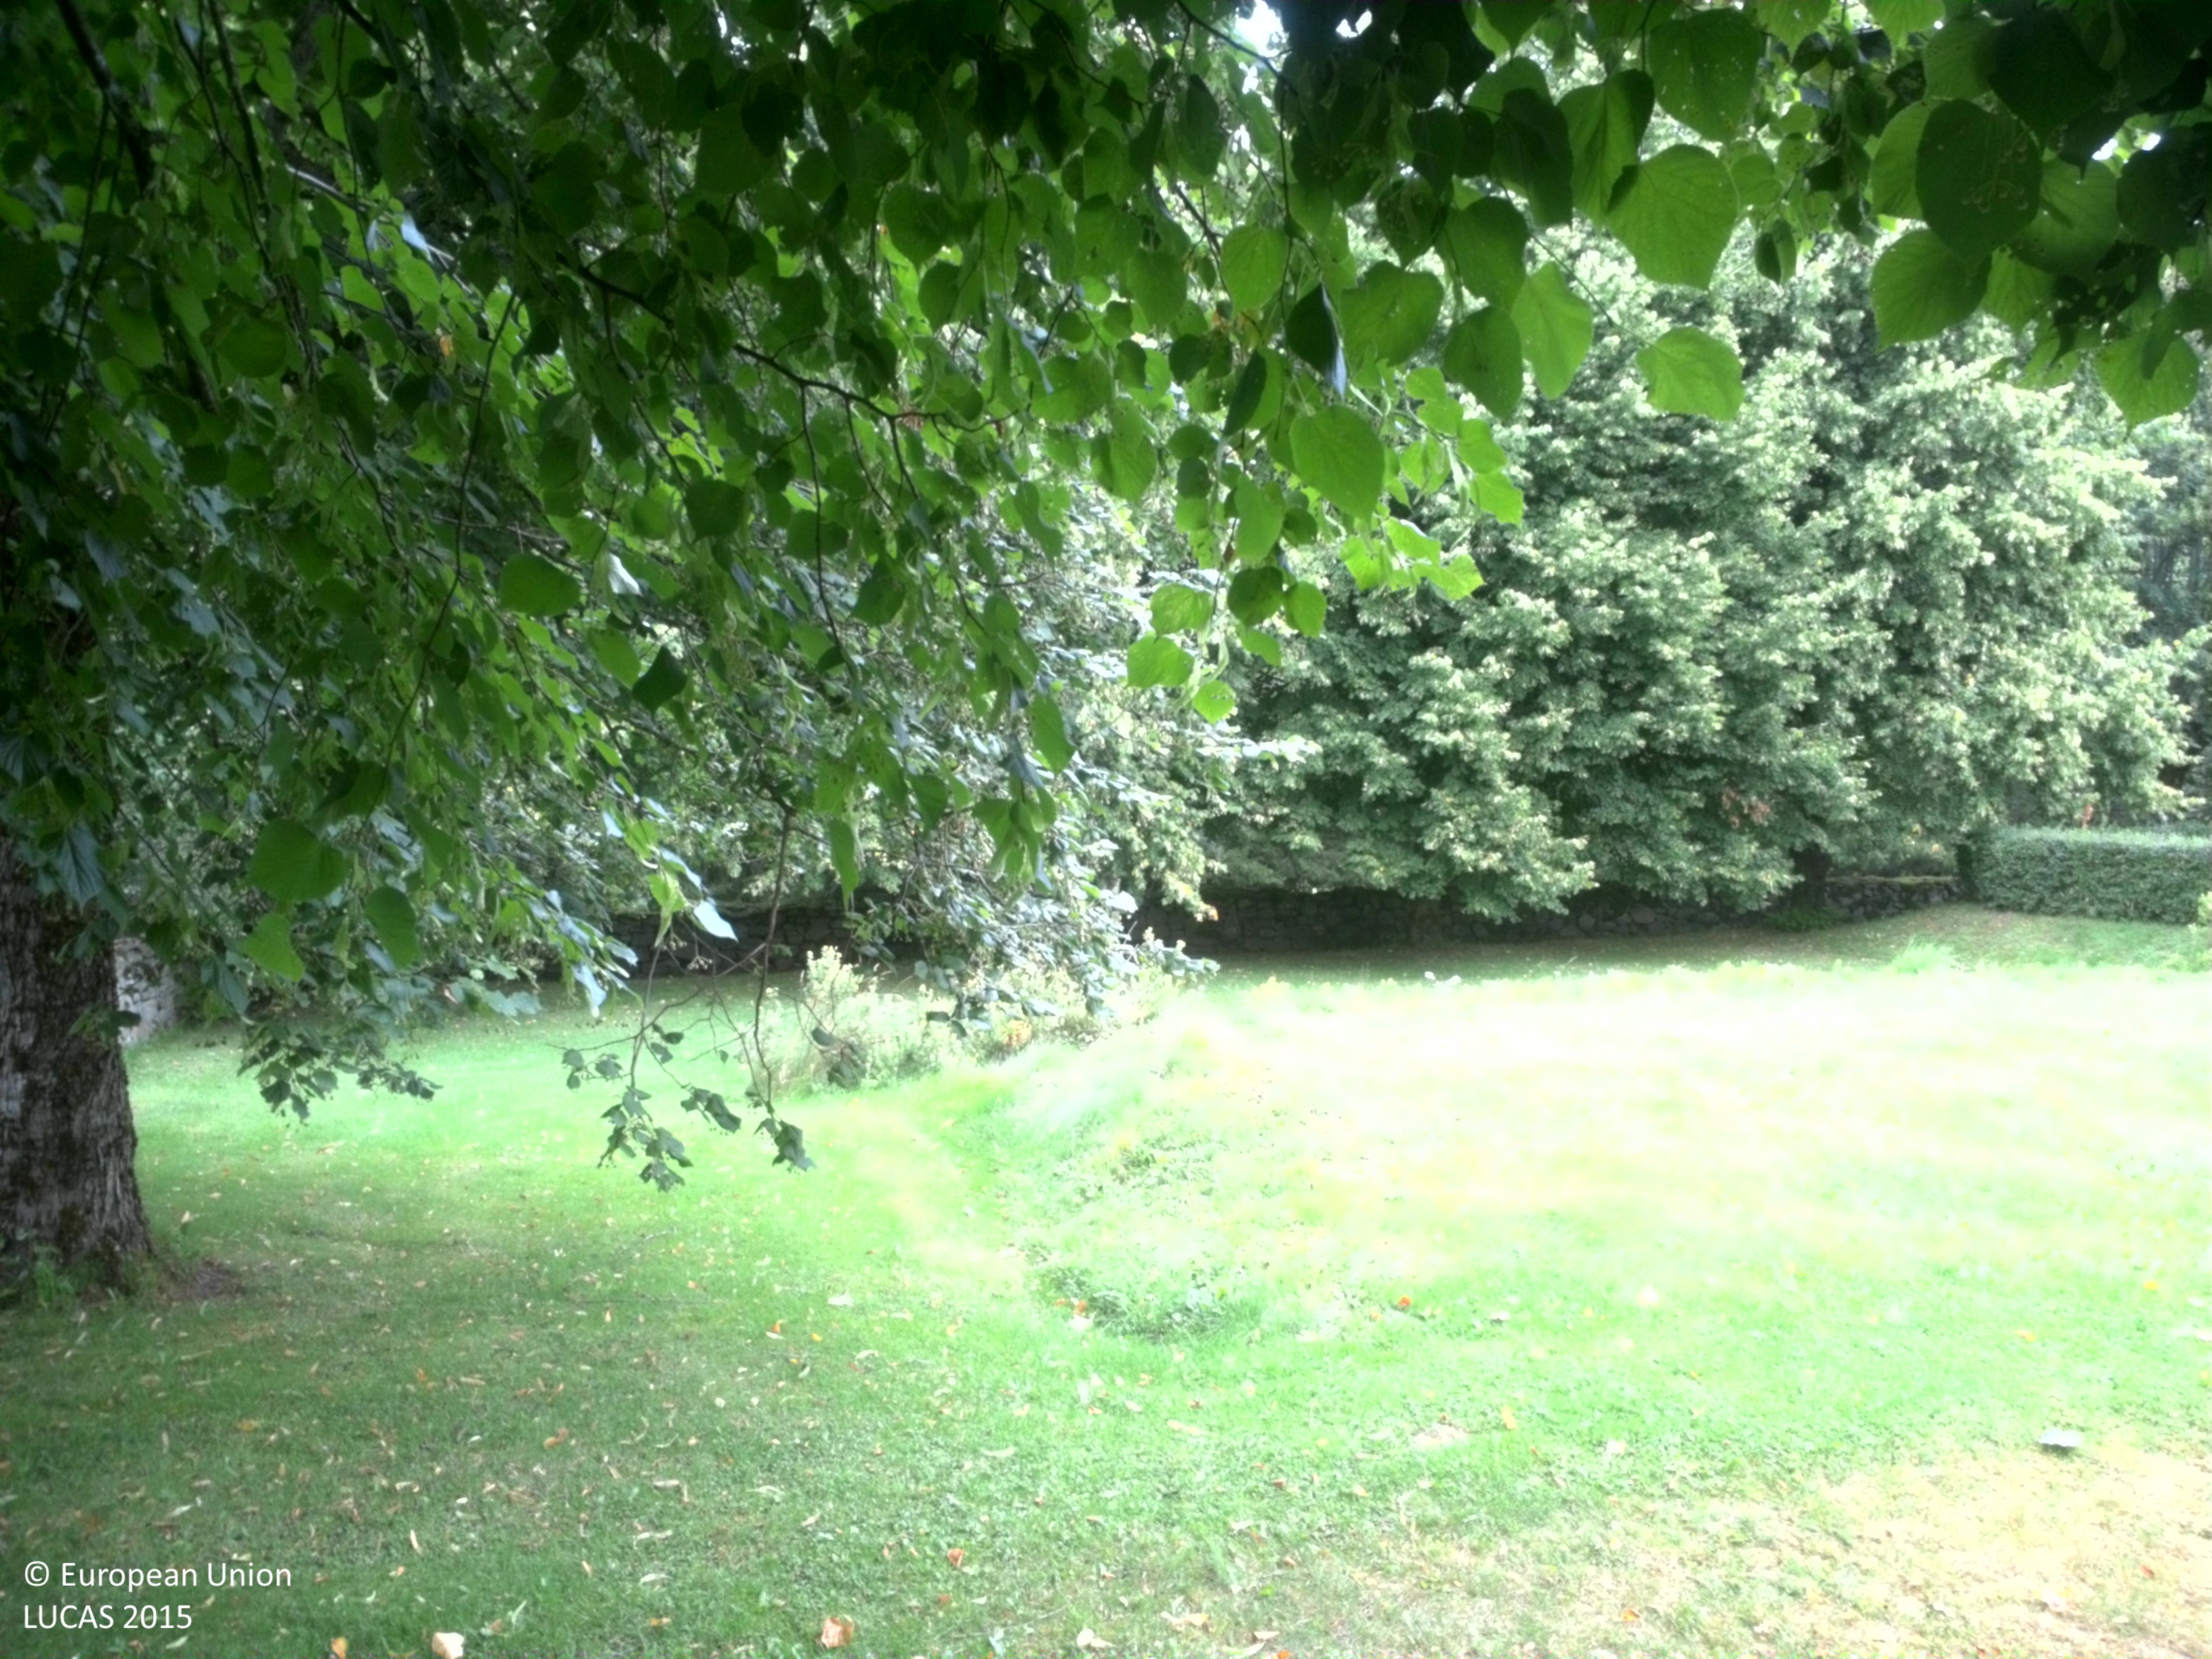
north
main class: Grassland
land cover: Grassland without tree/shrub cover
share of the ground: > 75 %
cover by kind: herbaceous plants 100 %
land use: Community services
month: August
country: SE
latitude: 57.8375
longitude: 13.2795
